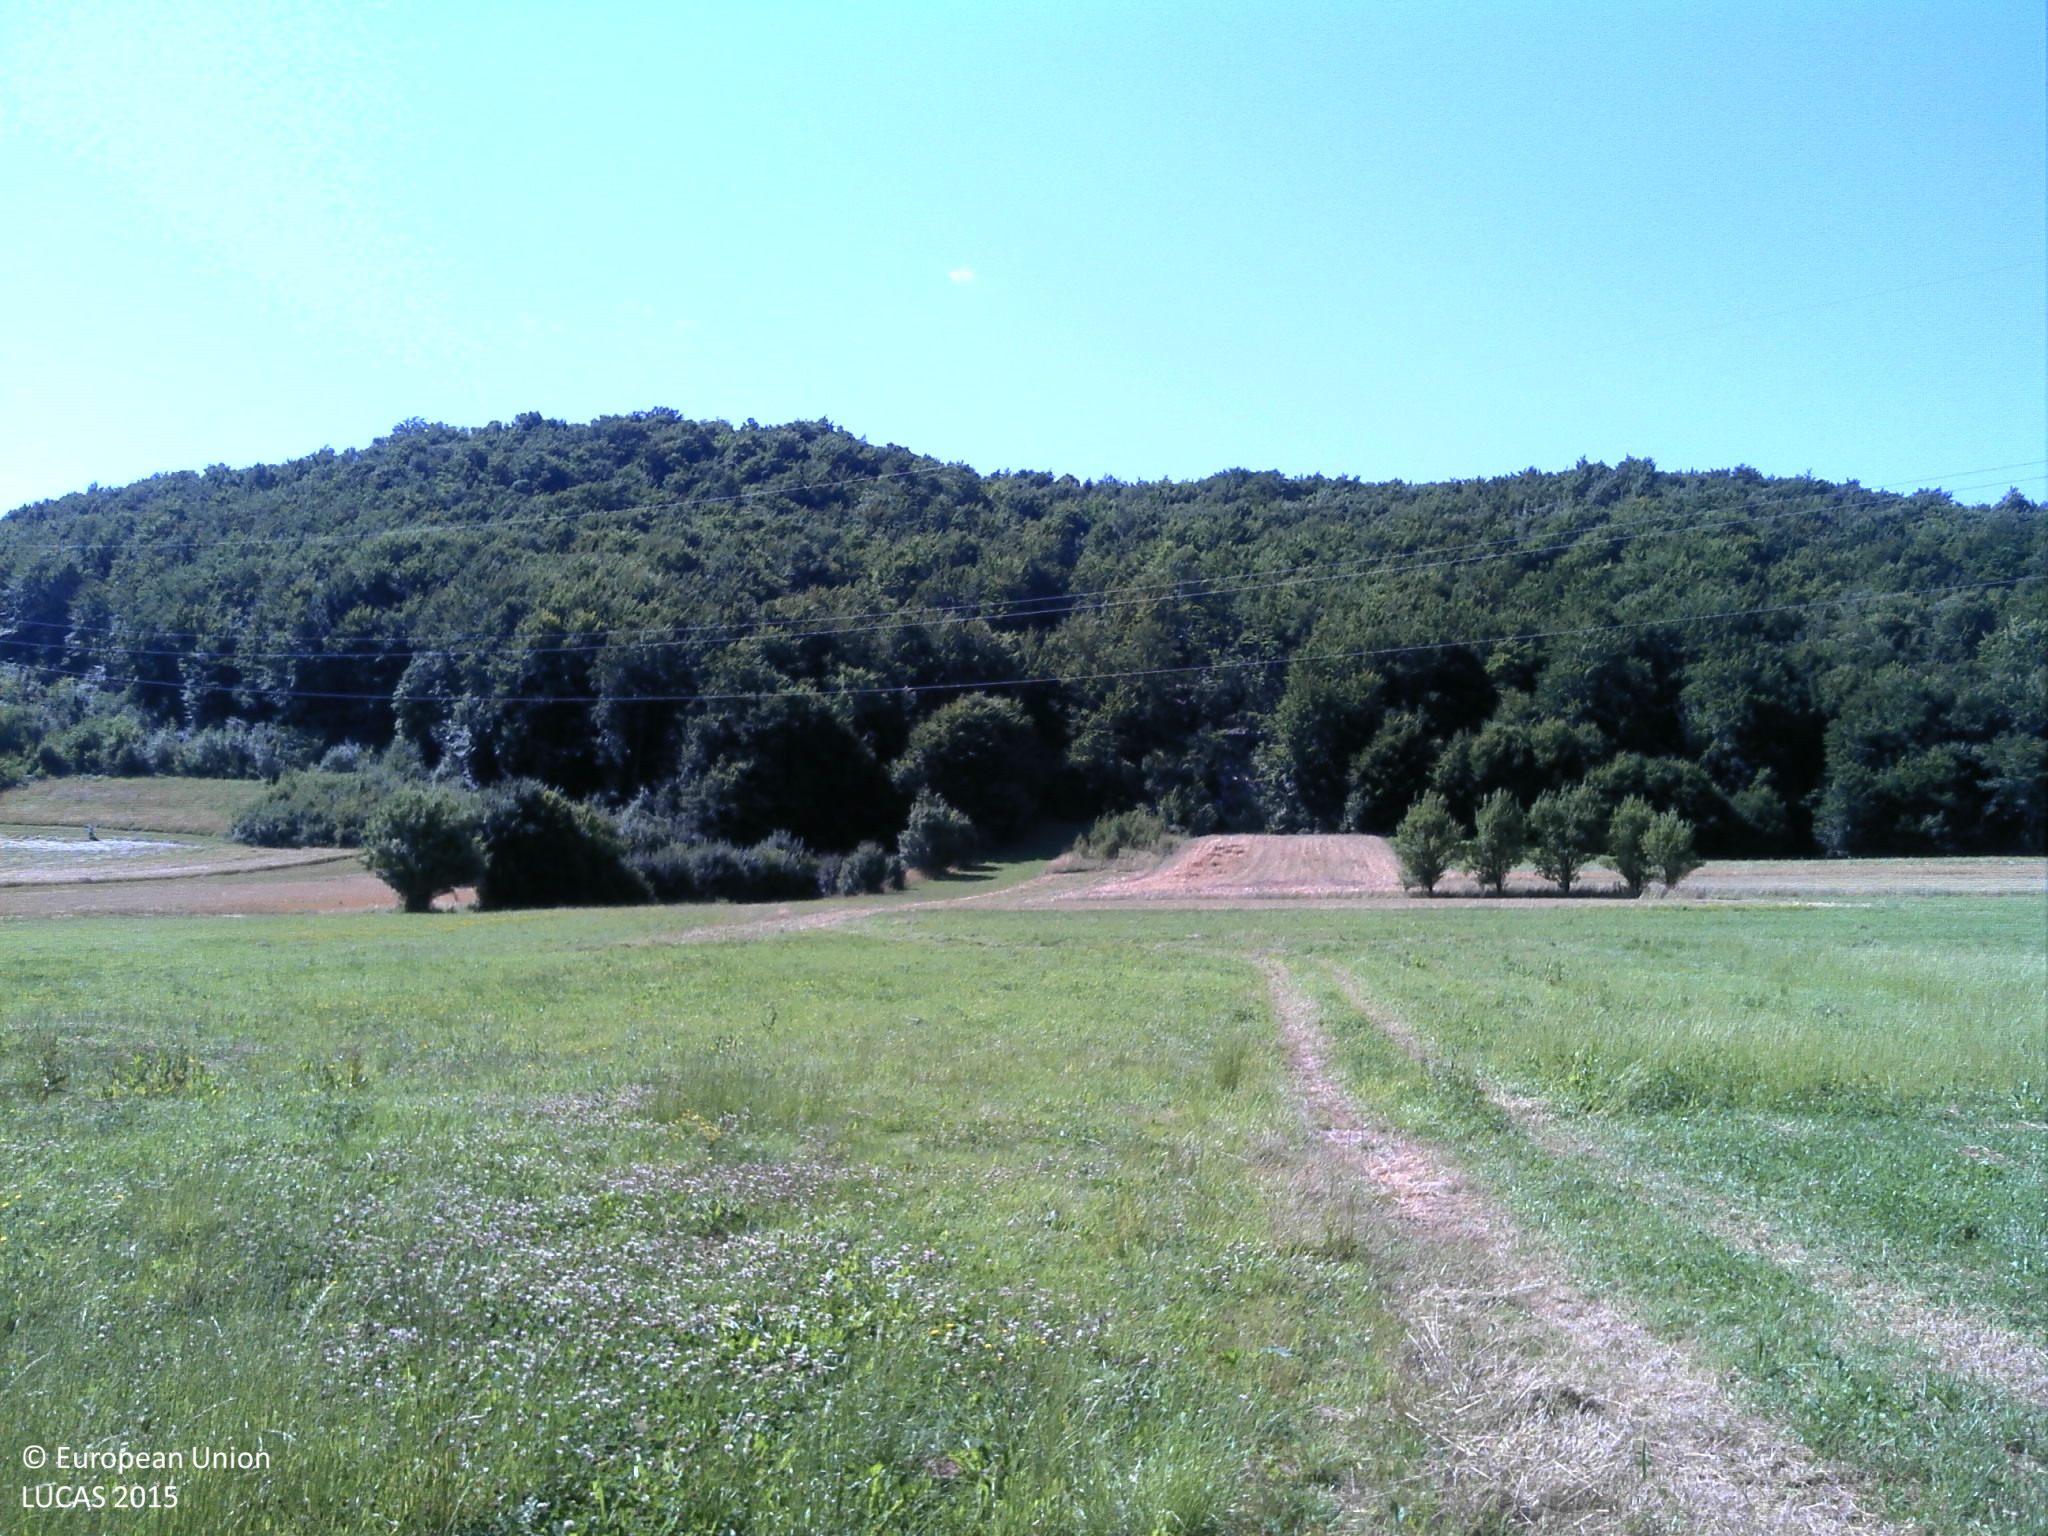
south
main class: Grassland
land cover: Grassland without tree/shrub cover
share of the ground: > 75 %
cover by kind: herbaceous plants 100 %
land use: Agriculture (excluding fallow land and kitchen gardens)
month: July
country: HR
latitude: 44.8503
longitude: 15.2451
